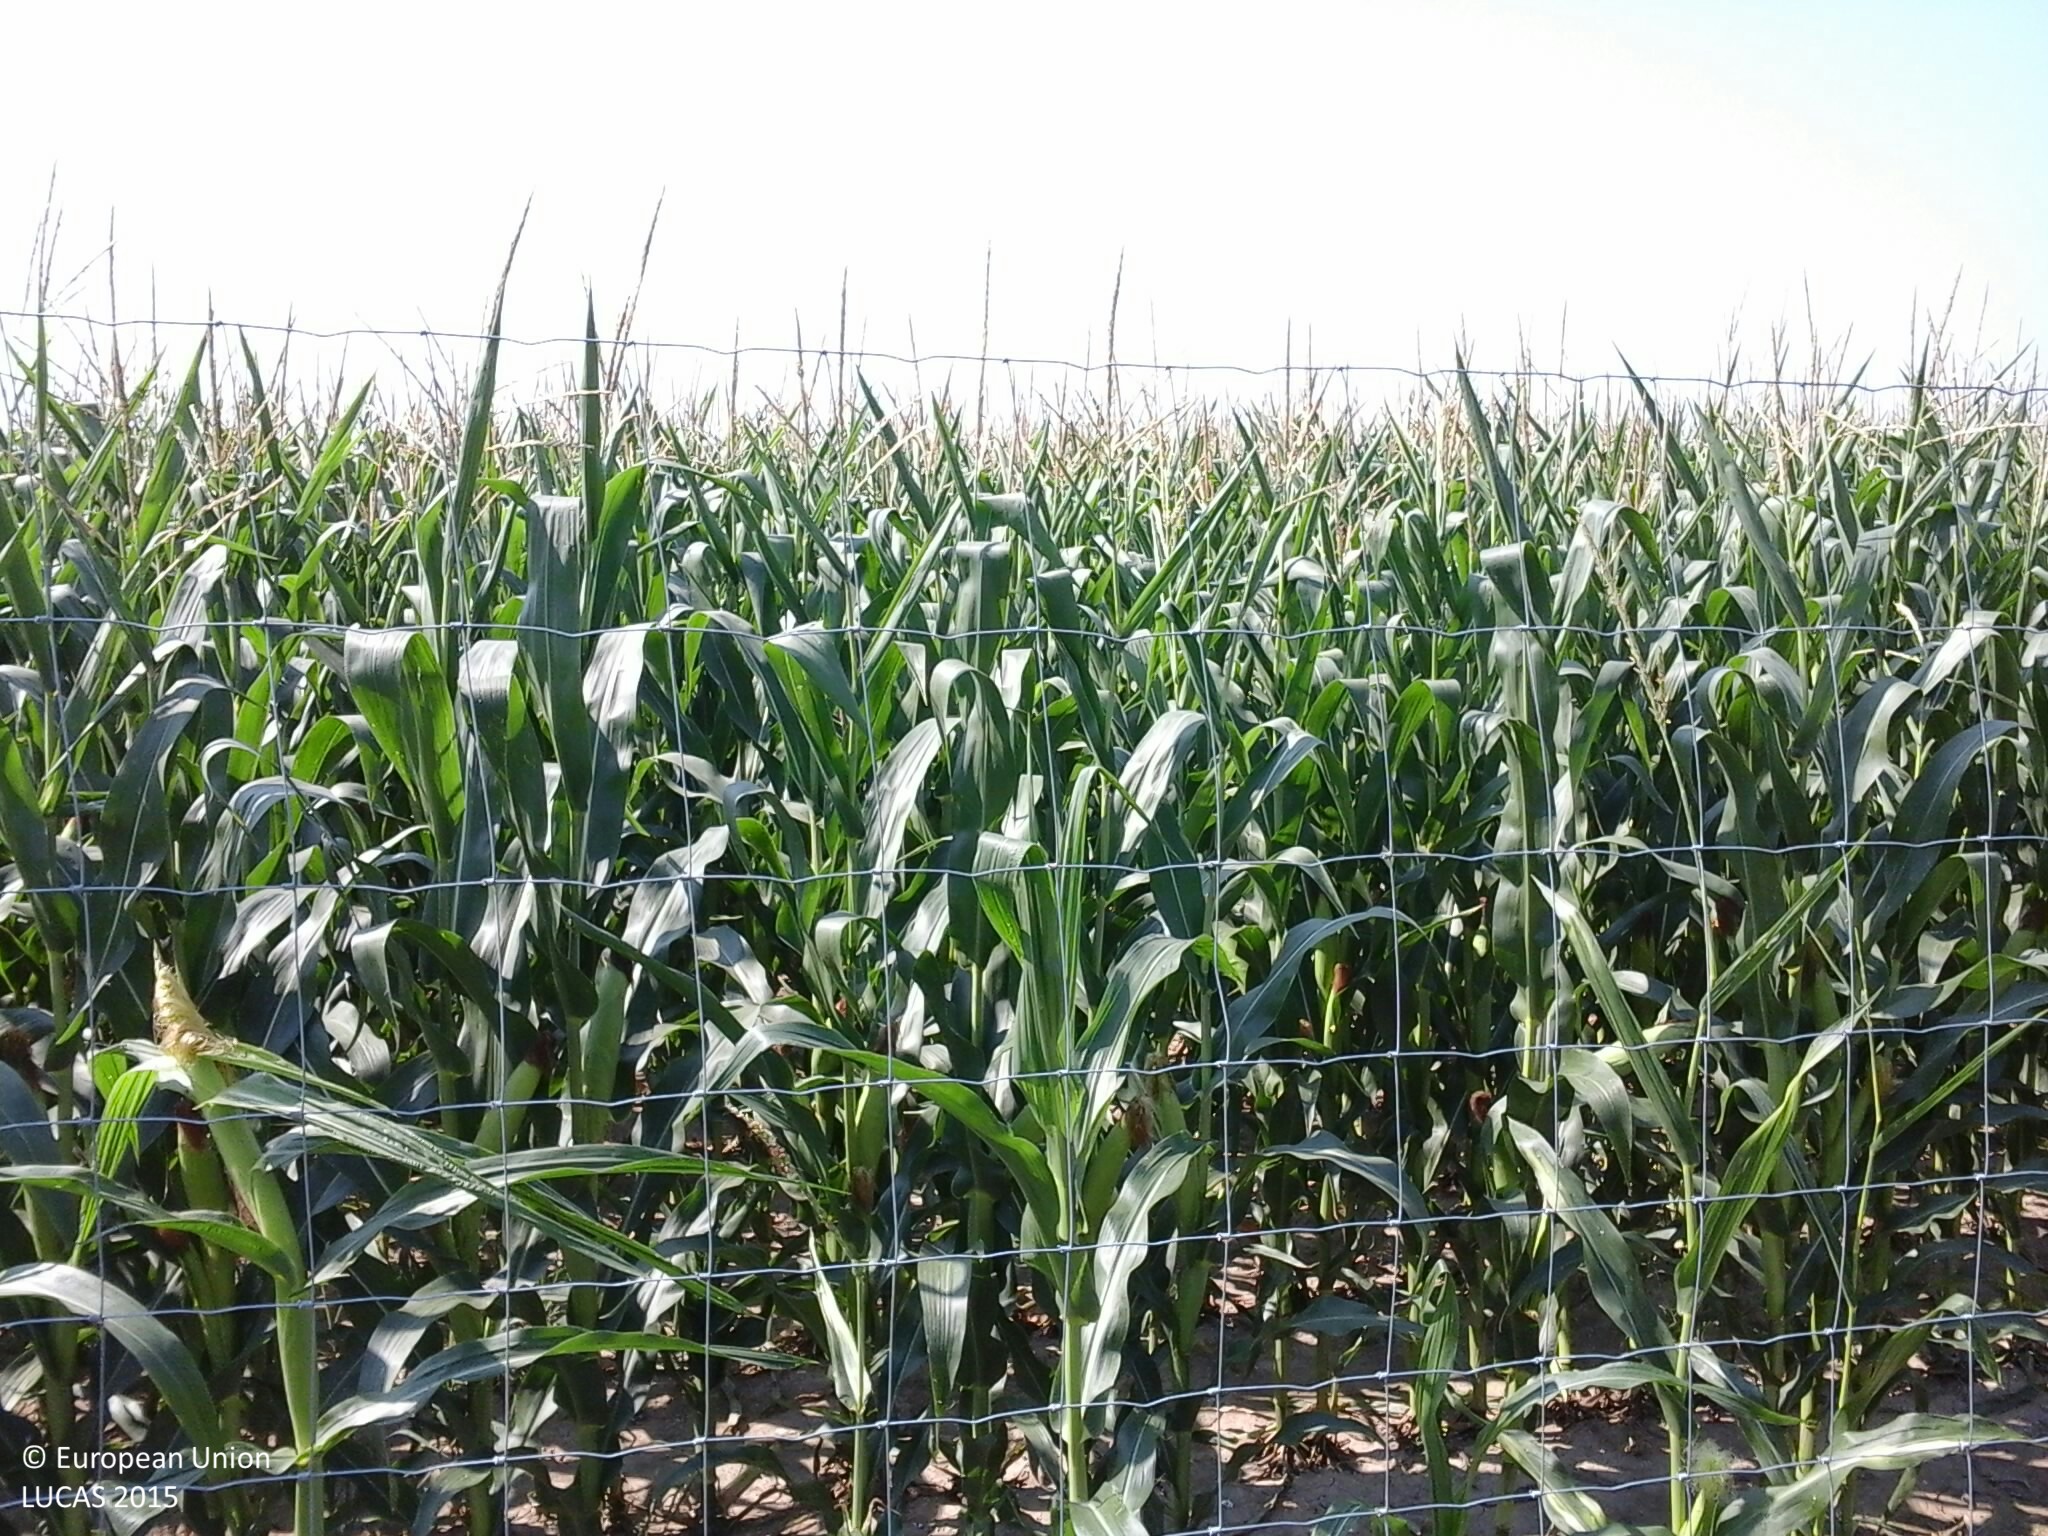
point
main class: Cropland
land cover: Maize
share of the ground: > 75 %
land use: Agriculture (excluding fallow land and kitchen gardens)
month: July
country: HU
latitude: 46.6743
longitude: 16.5509
